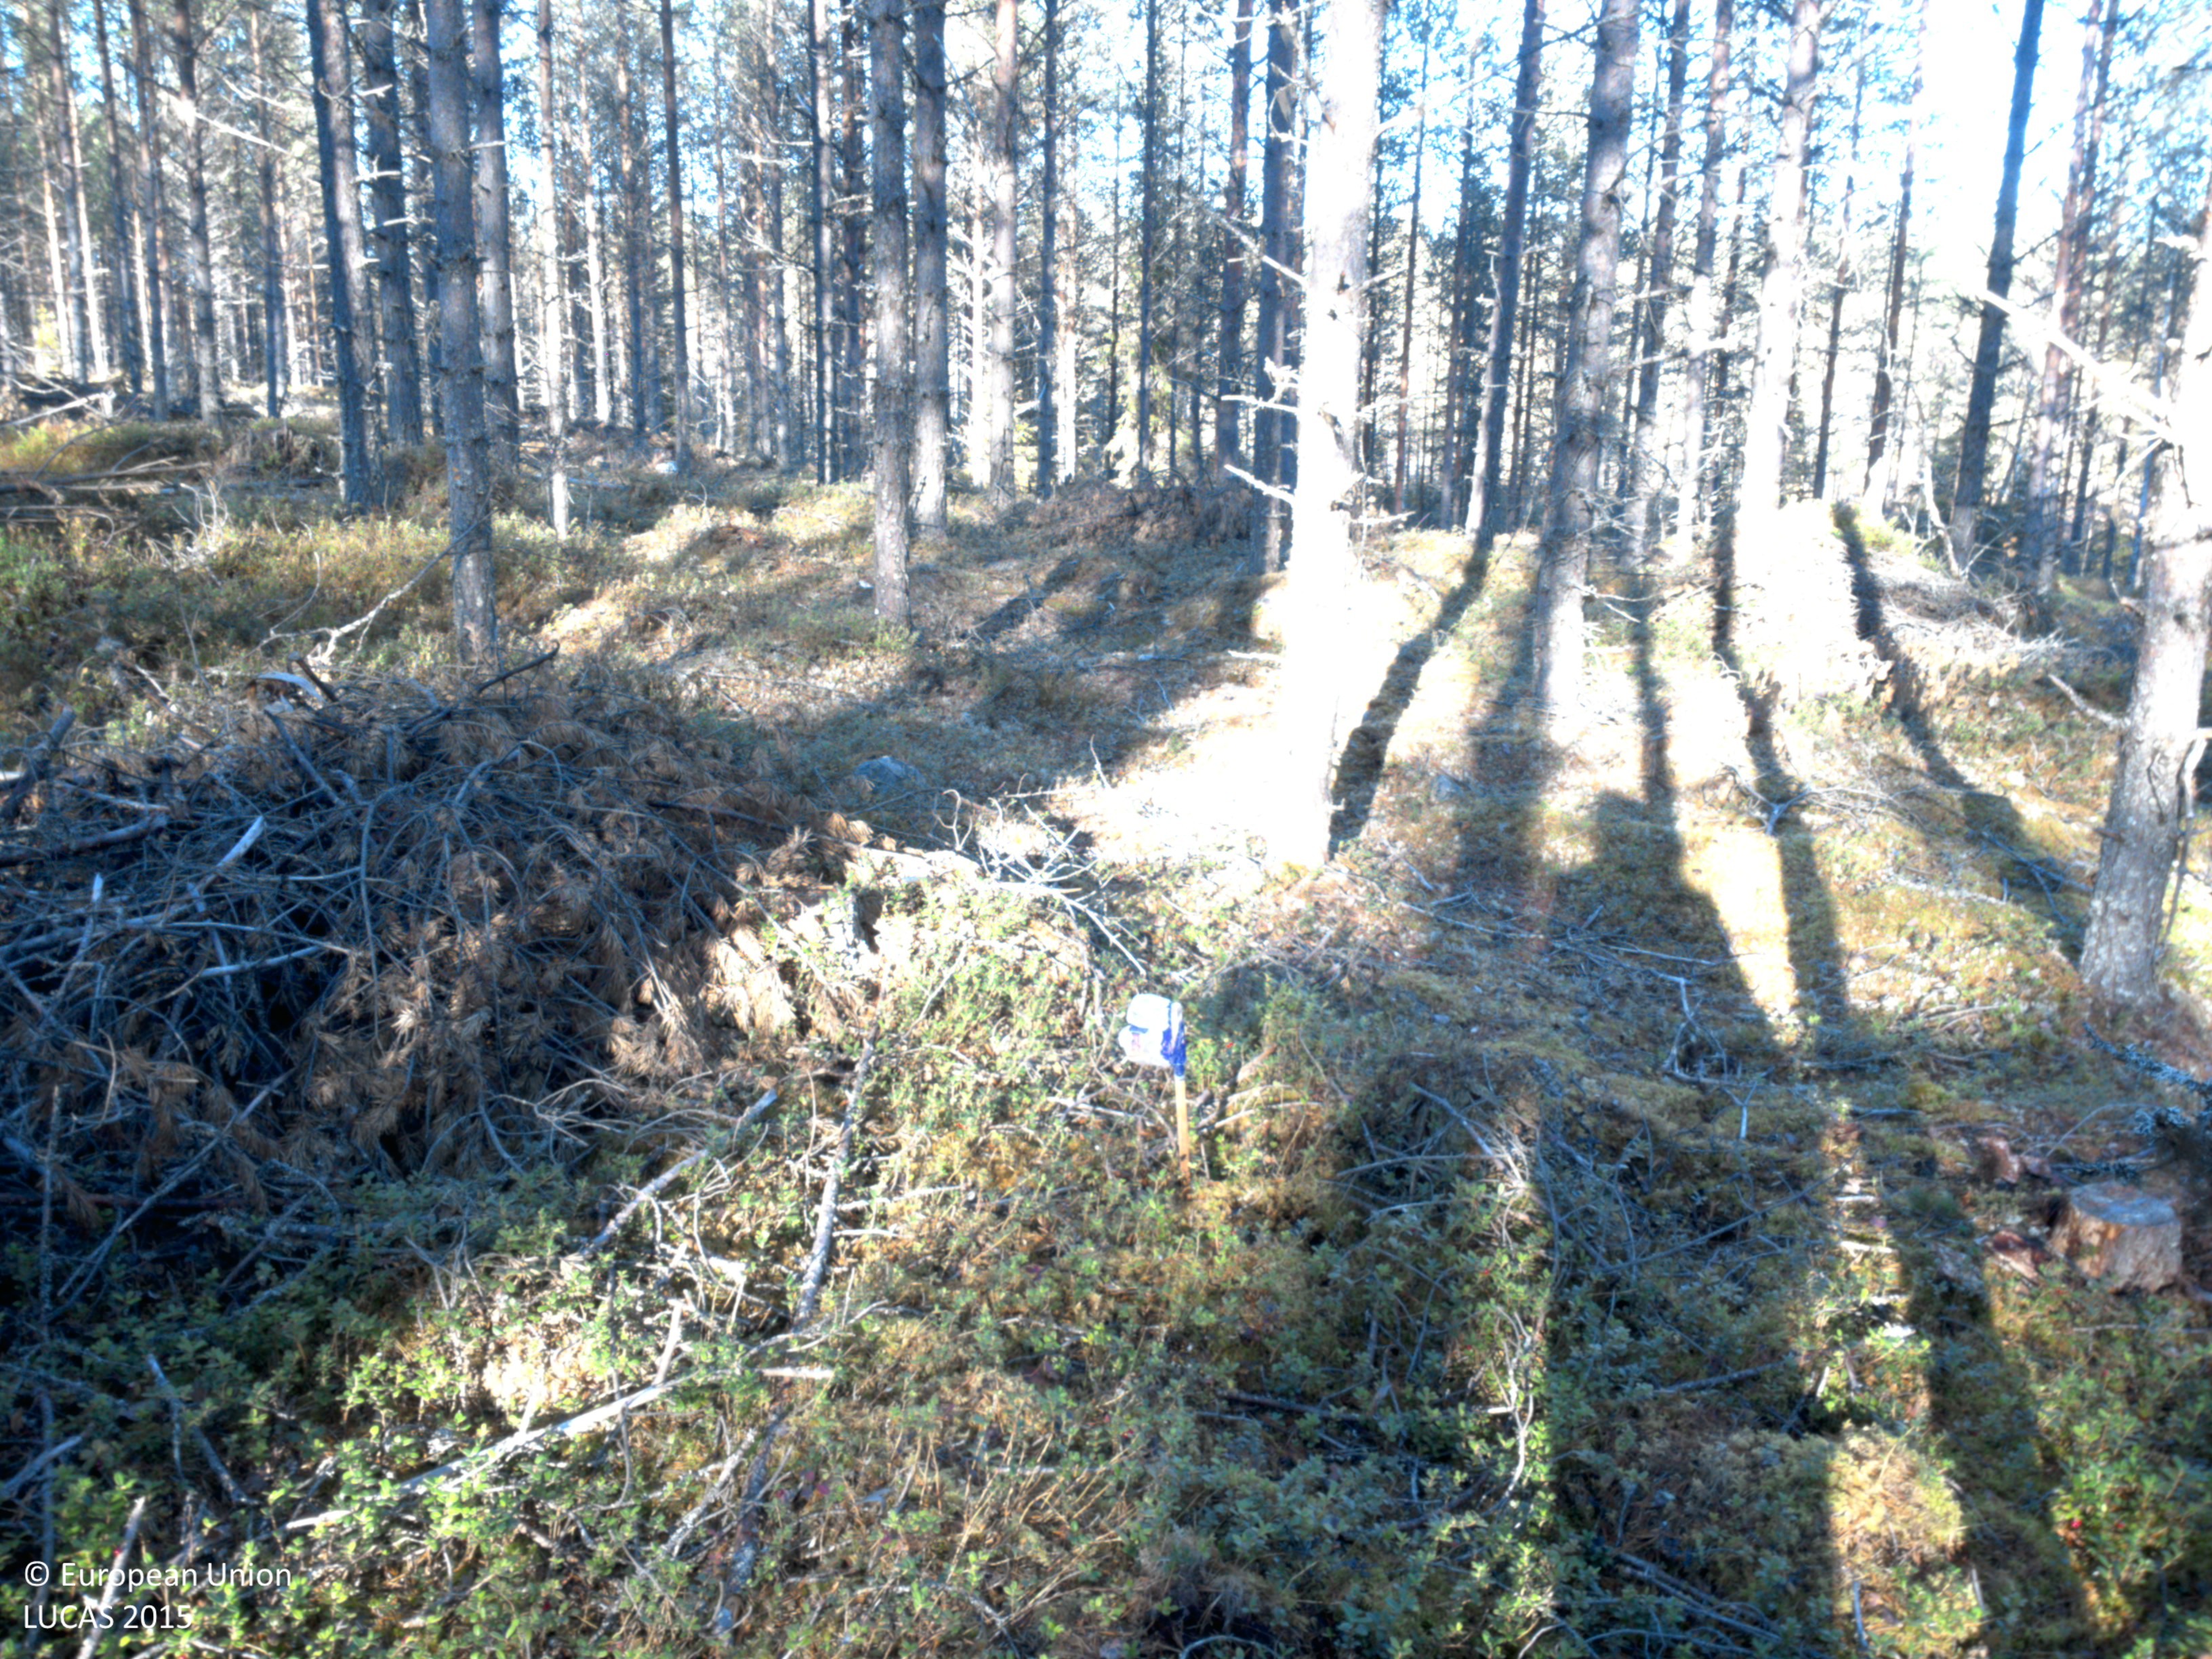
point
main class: Woodland
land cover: Pine dominated coniferous woodland
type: boreal forest
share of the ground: > 75 %
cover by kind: coniferous forest trees 80 %, shrubs 10 %, herbaceous plants 5 %, lichens and mosses 5 %
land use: Forestry
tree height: > 5 m
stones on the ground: 25 - 50 %
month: October
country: SE
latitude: 64.1247
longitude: 18.3296
